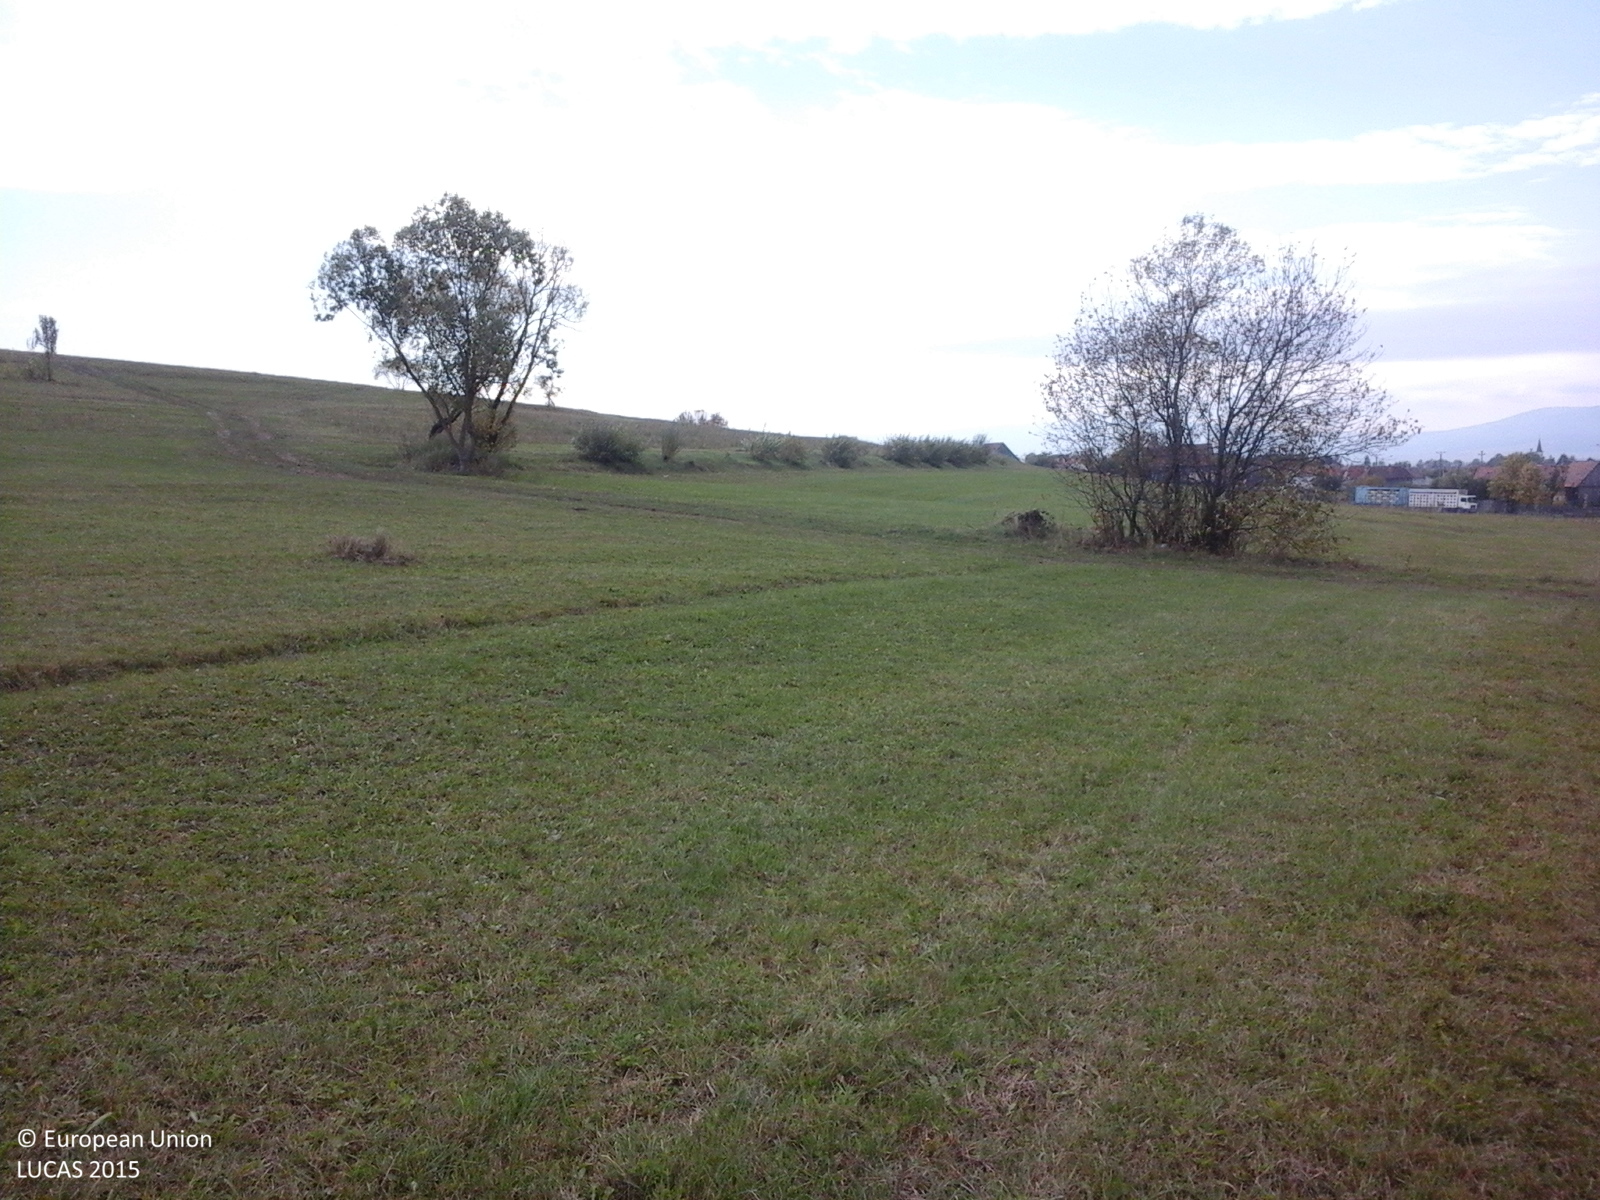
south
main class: Grassland
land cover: Grassland without tree/shrub cover
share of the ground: > 75 %
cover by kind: herbaceous plants 100 %
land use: Agriculture (excluding fallow land and kitchen gardens)
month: October
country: RO
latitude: 46.4820
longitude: 25.8392
